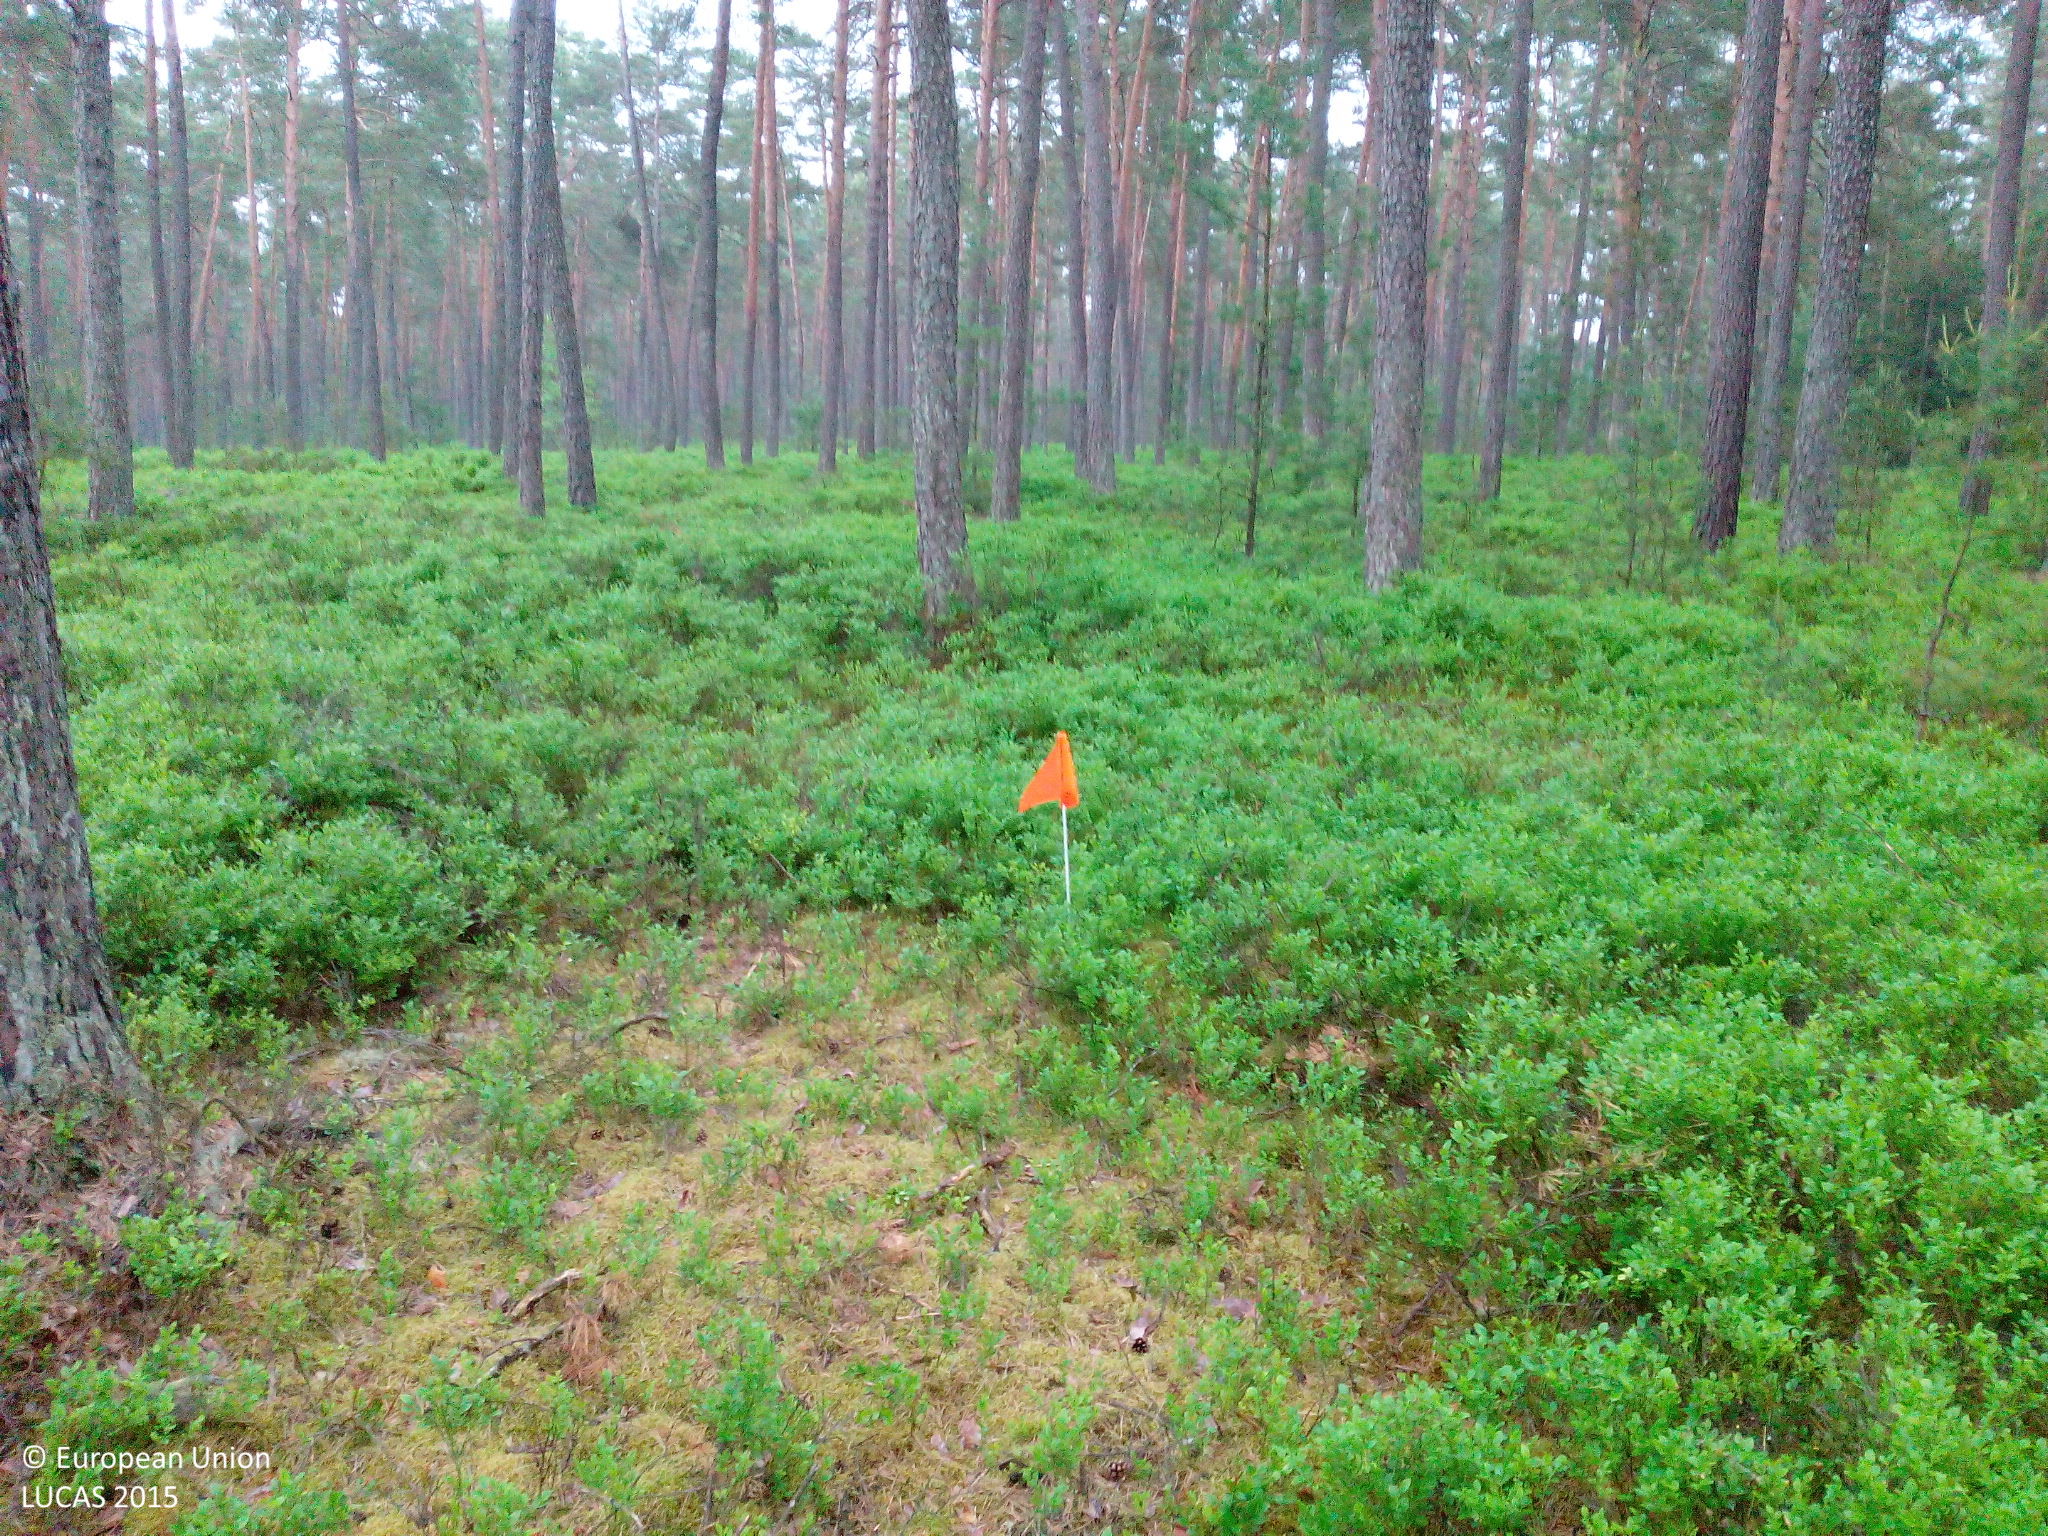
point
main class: Woodland
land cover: Pine dominated coniferous woodland
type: hemiboreal forest and nemoral coniferous forest and mixed broadleaved-coniferous forest
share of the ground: 50 - 75 %
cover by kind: coniferous forest trees 70 %, shrubs 20 %, herbaceous plants 10 %
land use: Forestry
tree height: > 5 m
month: June
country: DE
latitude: 49.2599
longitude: 12.3766
